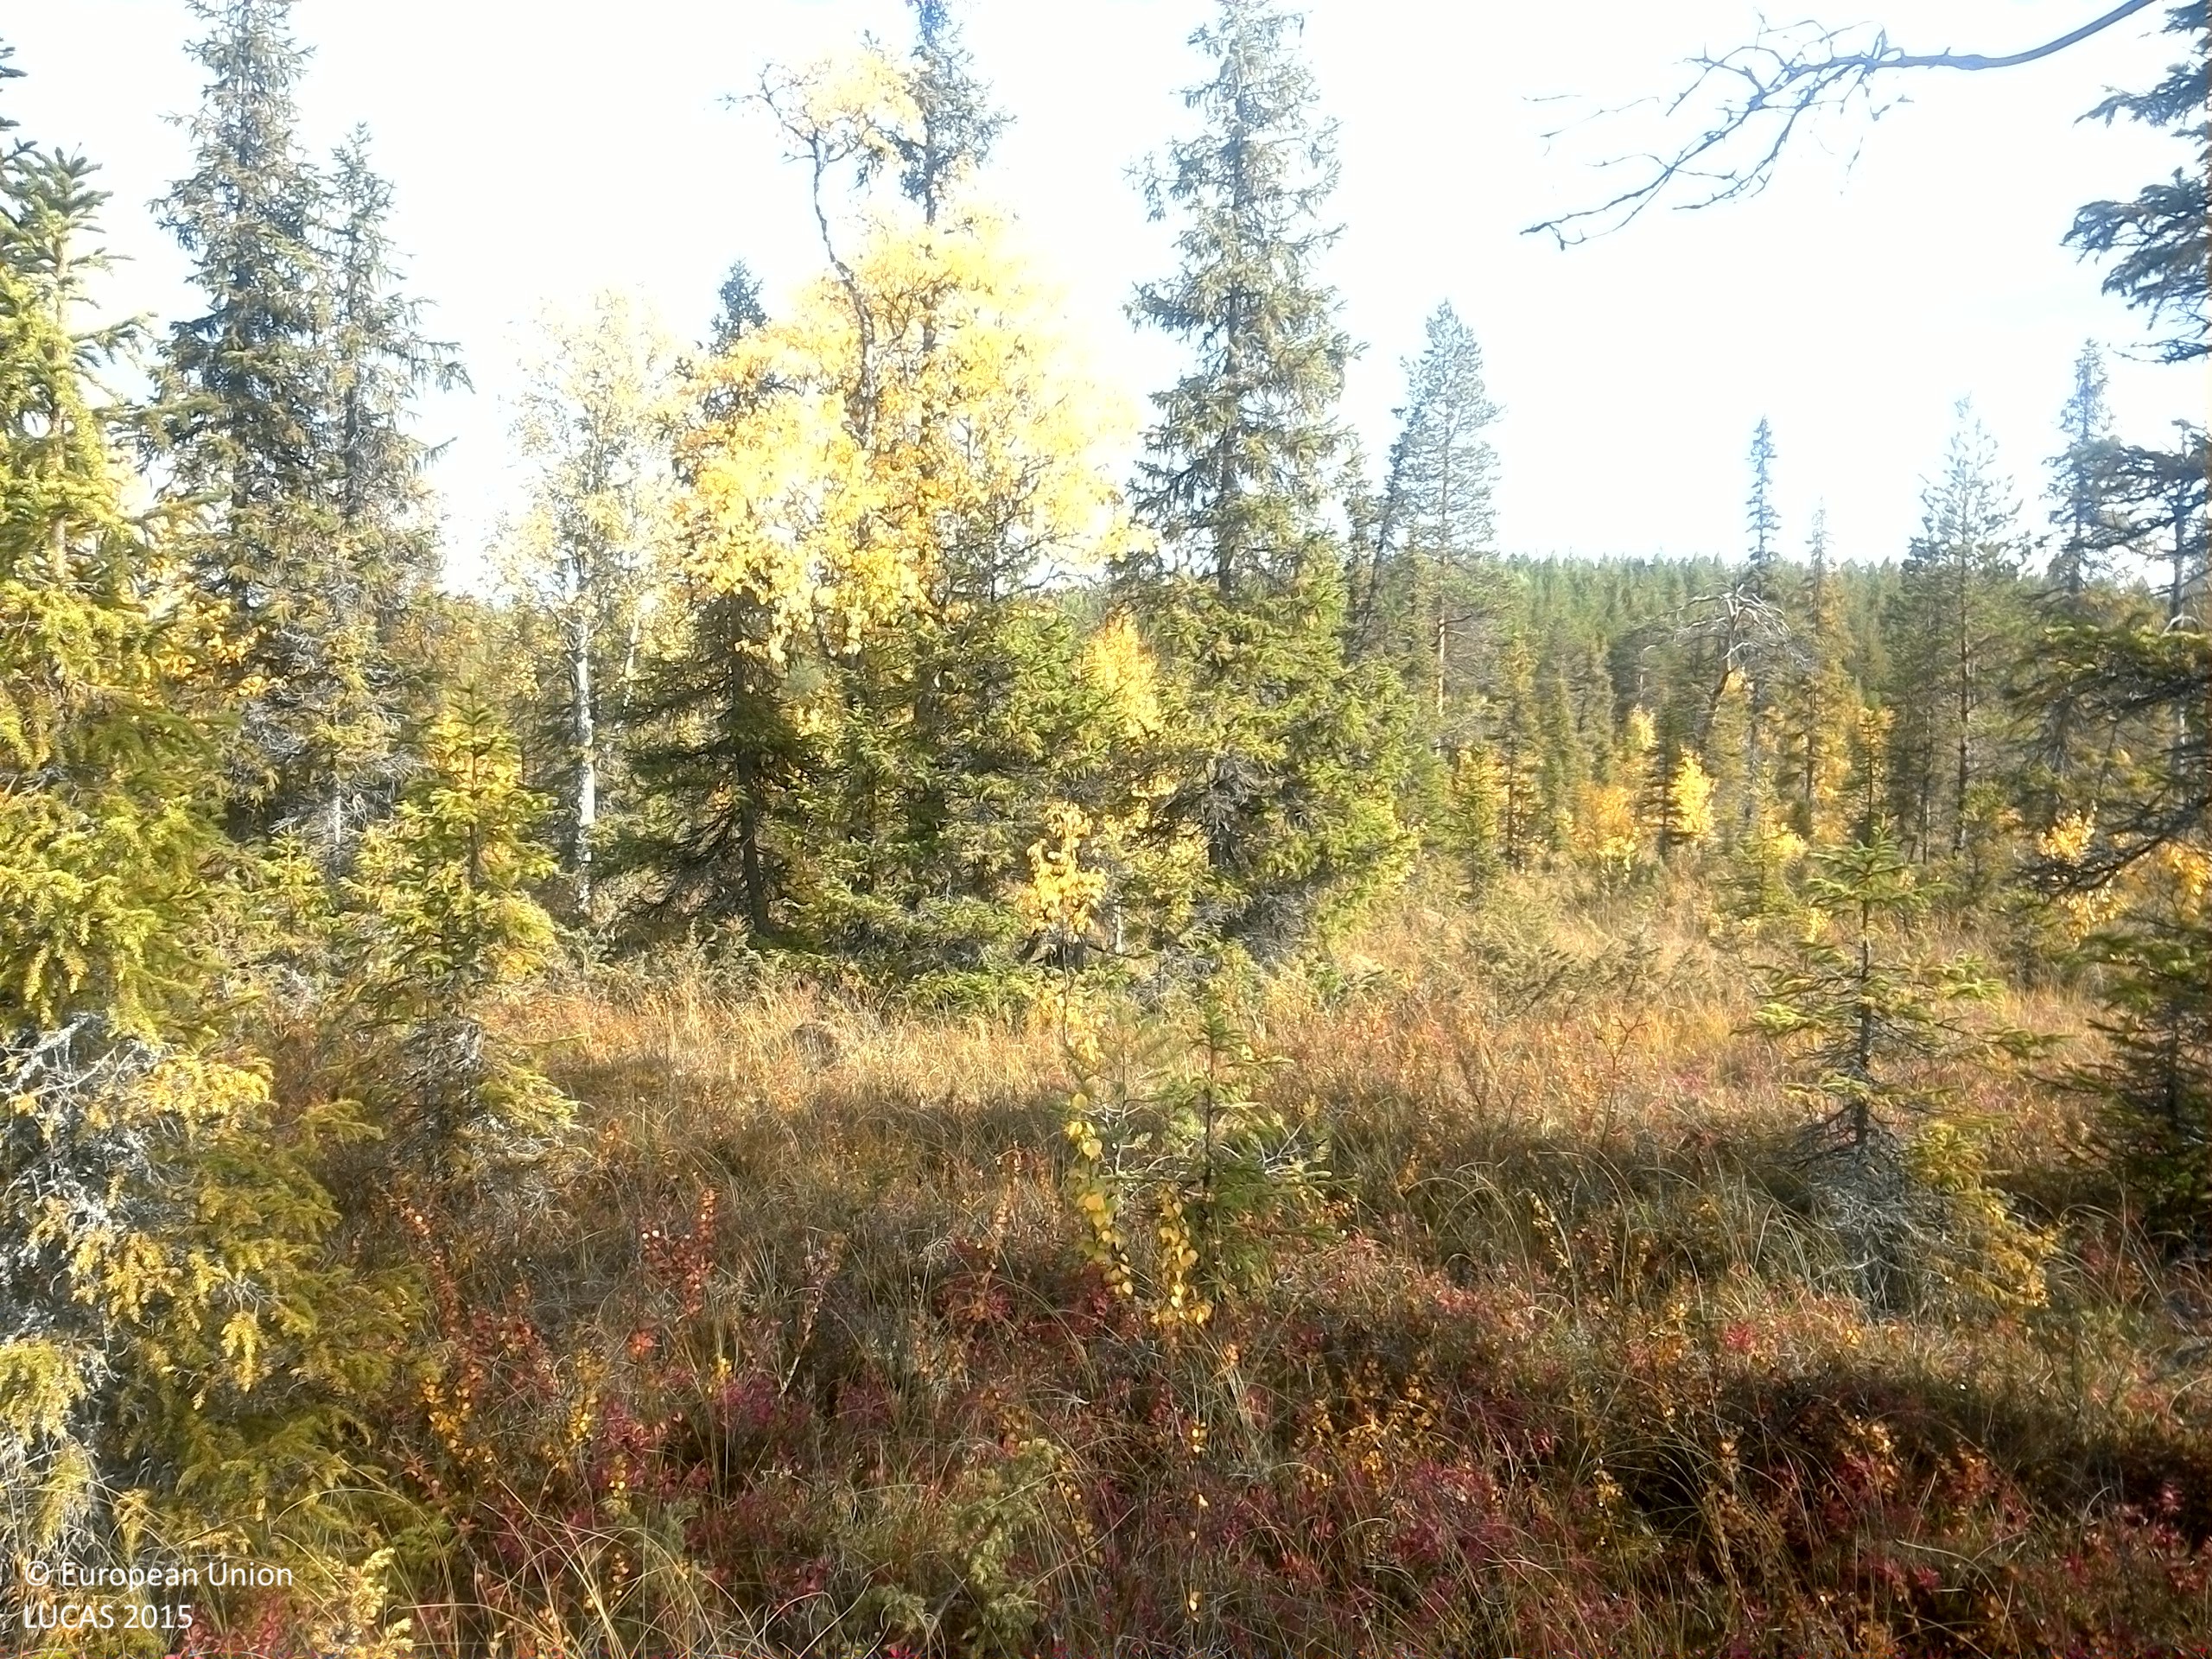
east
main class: Woodland
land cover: Spruce dominated mixed woodland
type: mire and swamp forests
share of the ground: 25 - 50 %
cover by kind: shrubs 50 %, lichens and mosses 20 %, coniferous forest trees 15 %, broadleaved forest trees 10 %, herbaceous plants 5 %
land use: Semi-natural and natural areas not in use
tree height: < 5 m
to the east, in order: Spruce dominated mixed woodland; Shrubland with sparse tree cover; Rivers and streams; Shrubland with sparse tree cover; Spruce dominated mixed woodland; Pine dominated mixed woodland
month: September
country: SE
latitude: 63.6011
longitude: 15.8805
